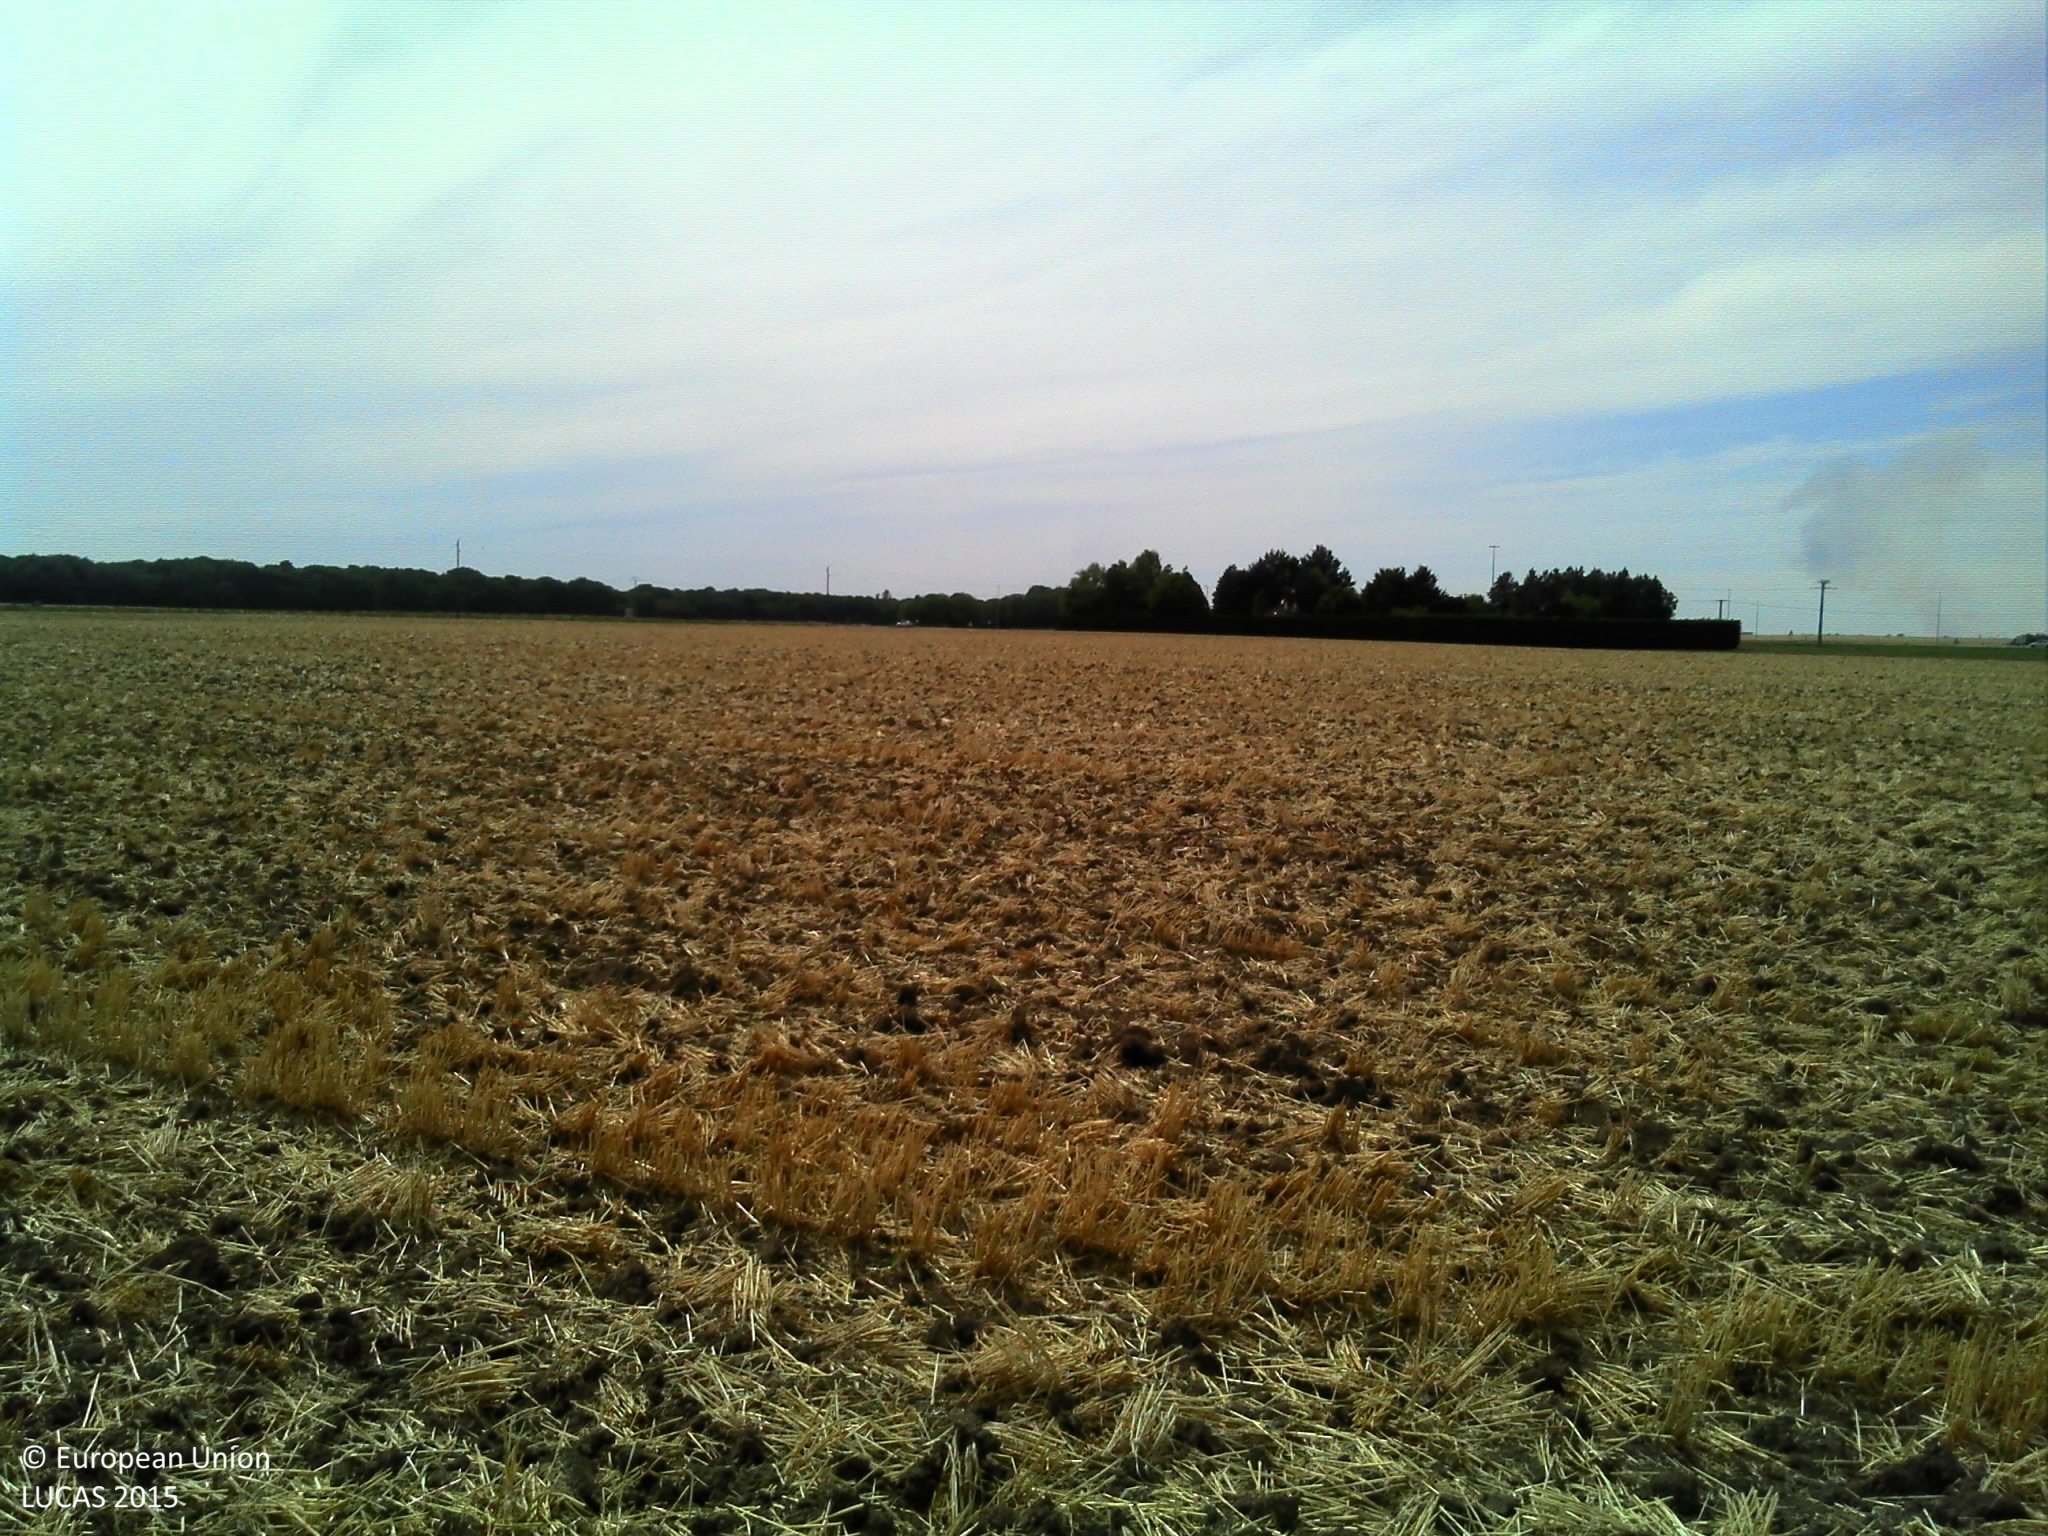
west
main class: Cropland
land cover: Barley
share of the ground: > 75 %
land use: Agriculture (excluding fallow land and kitchen gardens)
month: July
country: FR
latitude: 48.0594
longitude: 2.0039
